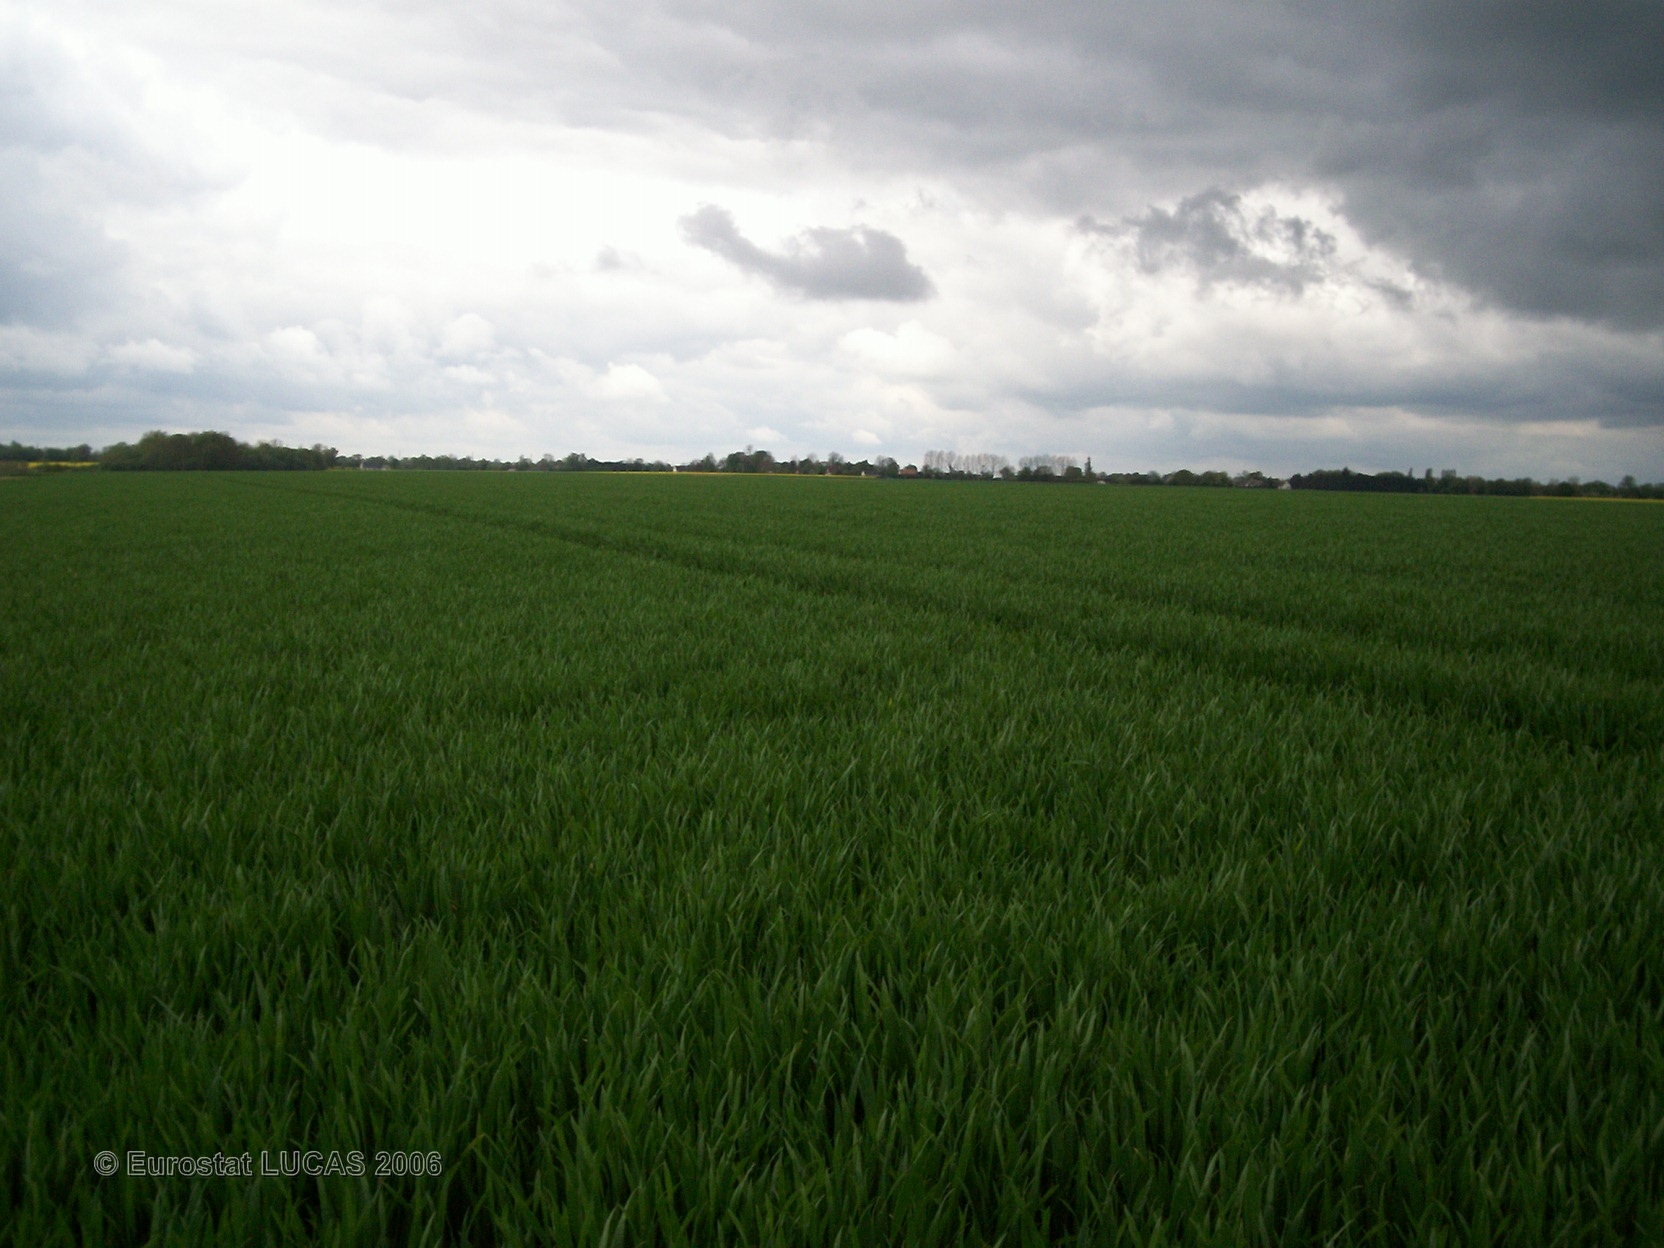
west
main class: Cropland
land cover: Common wheat
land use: Agriculture (excluding fallow land and kitchen gardens)
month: May
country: FR
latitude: 49.0460
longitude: 0.5203
